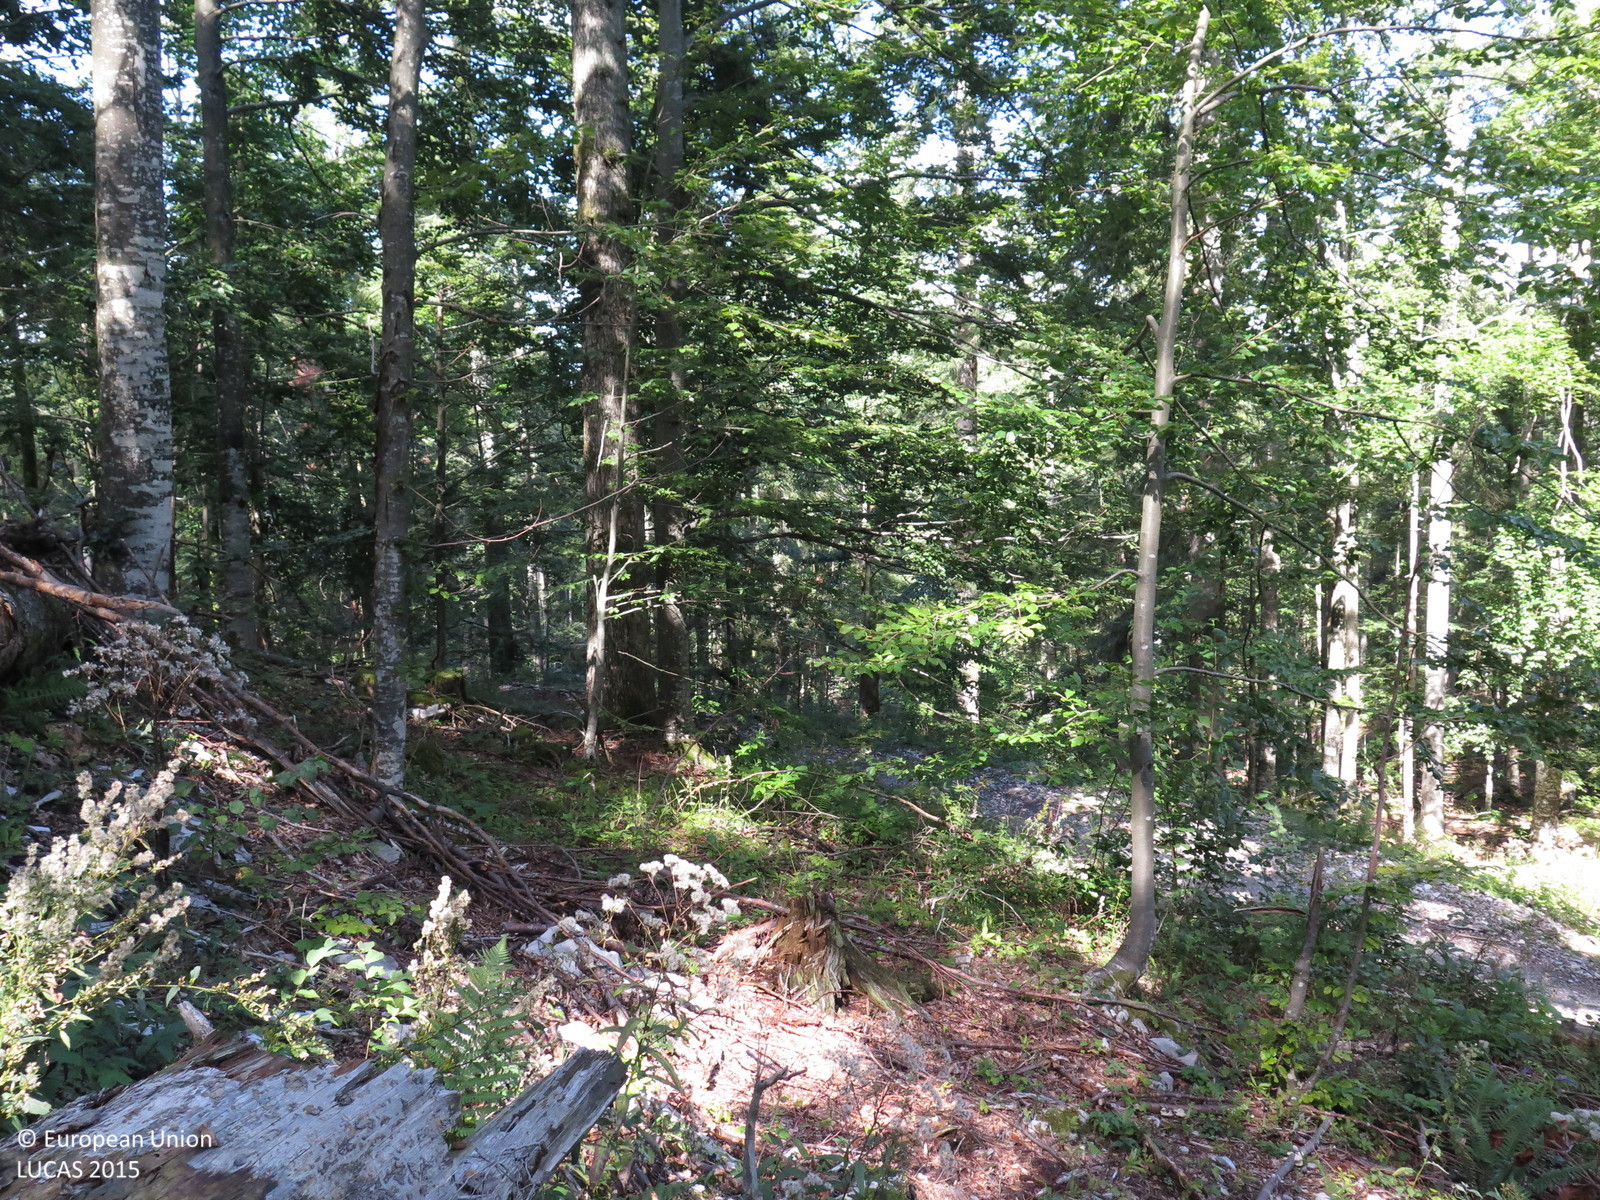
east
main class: Woodland
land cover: Other mixed woodland
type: mountainous beech forest
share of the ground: > 75 %
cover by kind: broadleaved forest trees 70 %, coniferous forest trees 25 %, unconsolidated bare surface 5 %
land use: Forestry
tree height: > 5 m
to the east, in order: Other mixed woodland; Shruby margins; Tracks; Other mixed woodland; Tracks; Rocks and stones; Other mixed woodland; Tracks; Grass margins; Other mixed woodland
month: September
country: HR
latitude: 45.4736
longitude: 14.6643
